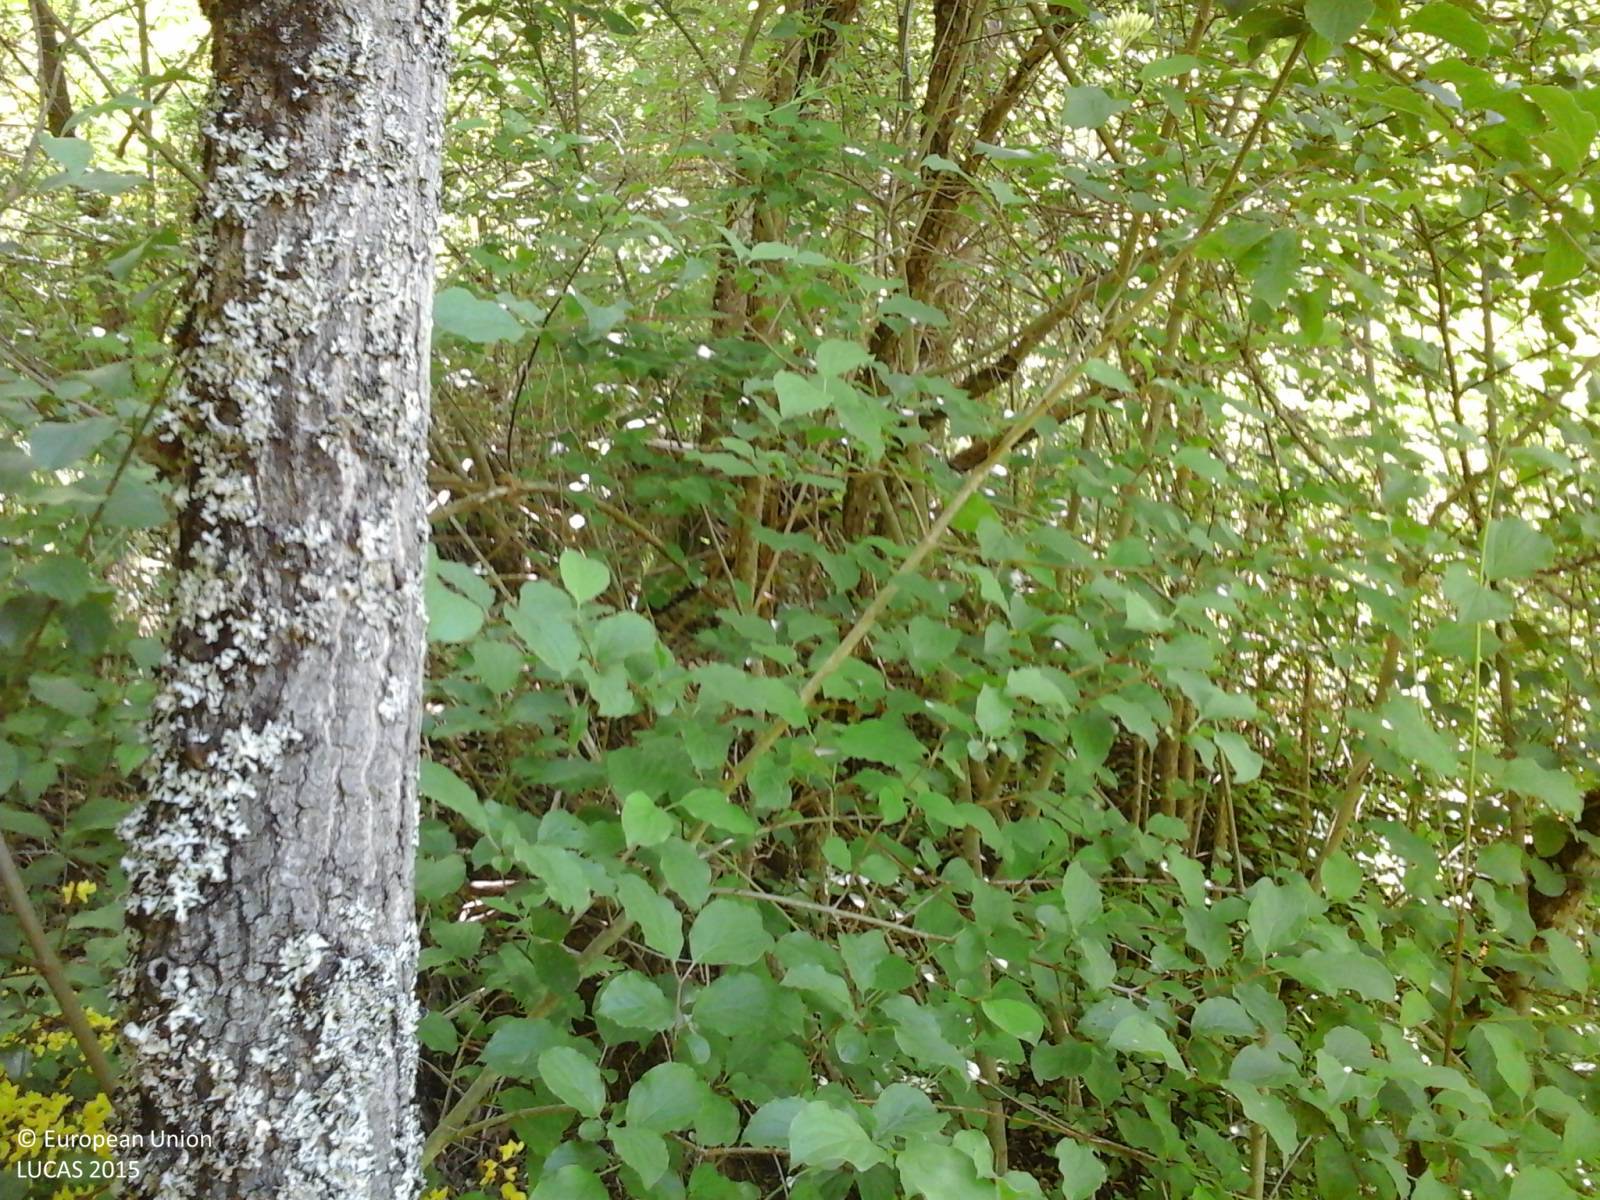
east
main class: Woodland
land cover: Broadleaved woodland
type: thermophilous deciduous forest
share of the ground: > 75 %
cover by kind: broadleaved forest trees 90 %, shrubs 5 %, herbaceous plants 5 %
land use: Forestry
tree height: > 5 m
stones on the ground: < 10 %
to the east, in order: Broadleaved woodland; Shrubland with sparse tree cover; Broadleaved woodland
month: May
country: IT
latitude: 42.1148
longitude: 13.2182
